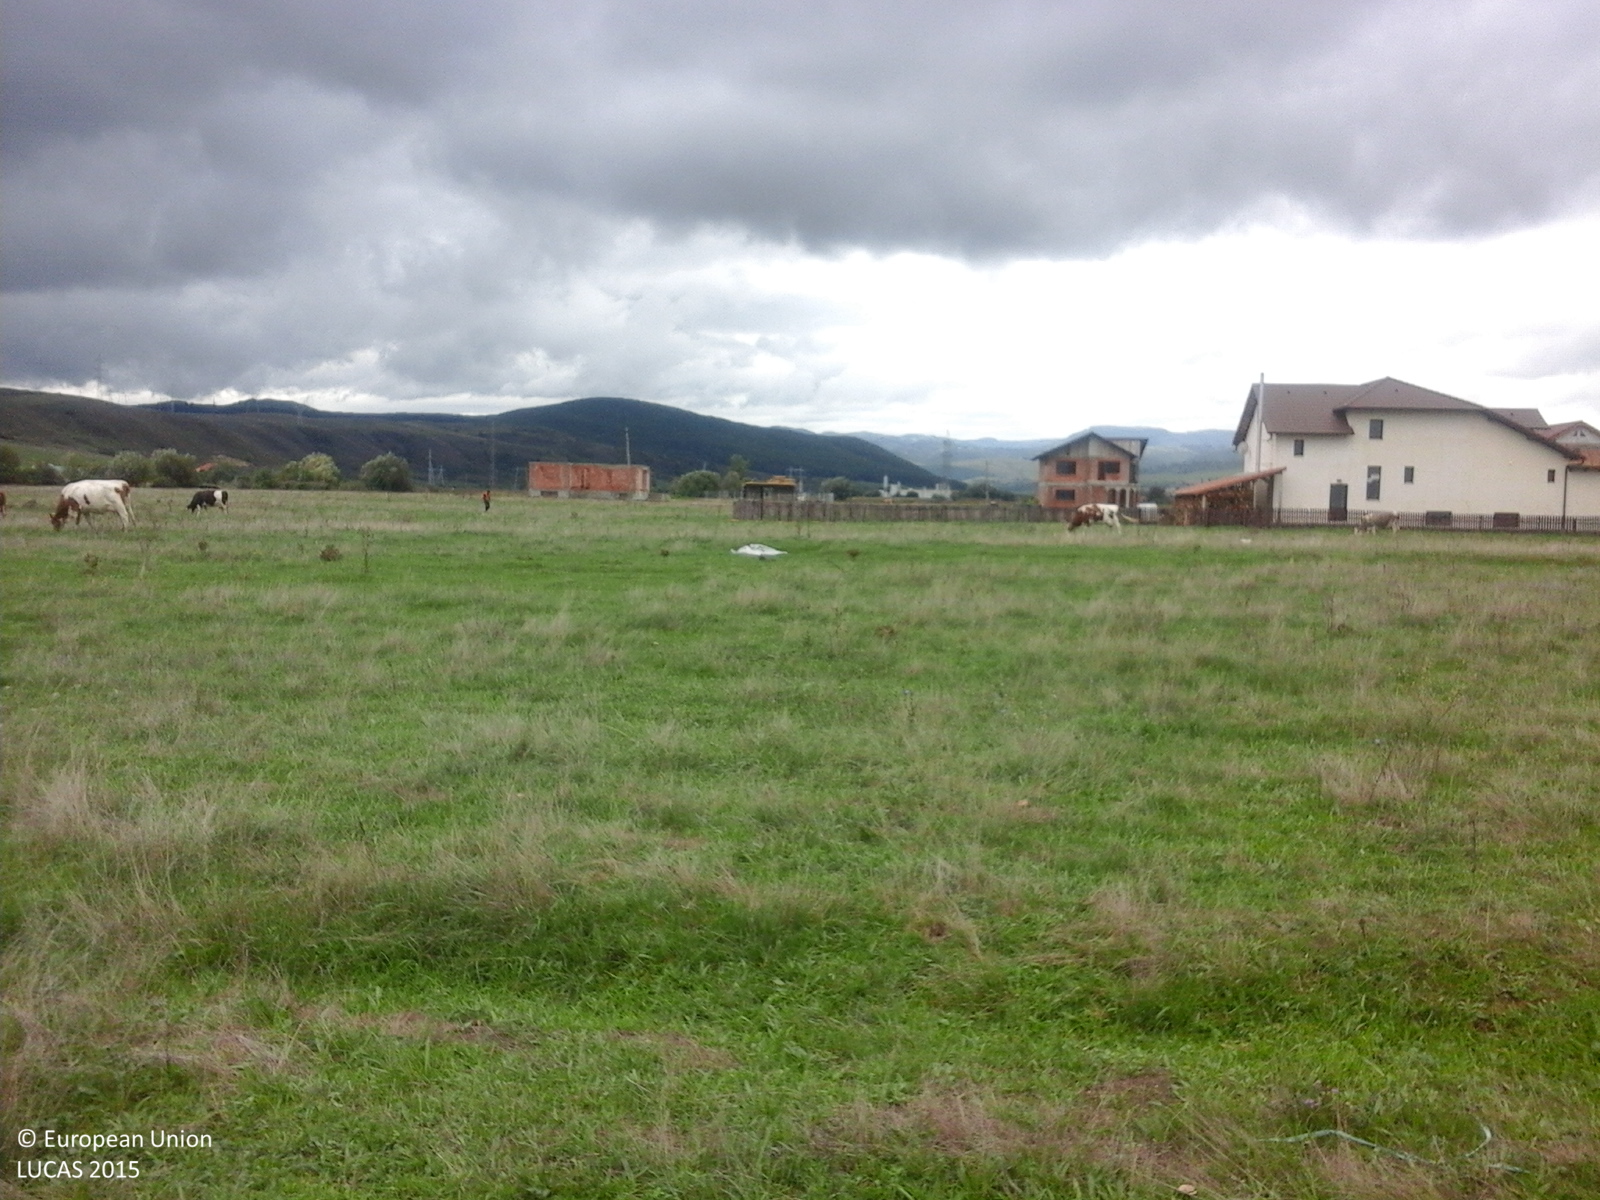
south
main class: Grassland
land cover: Grassland without tree/shrub cover
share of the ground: > 75 %
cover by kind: herbaceous plants 100 %
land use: Agriculture (excluding fallow land and kitchen gardens)
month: September
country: RO
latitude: 45.9380
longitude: 23.5695
